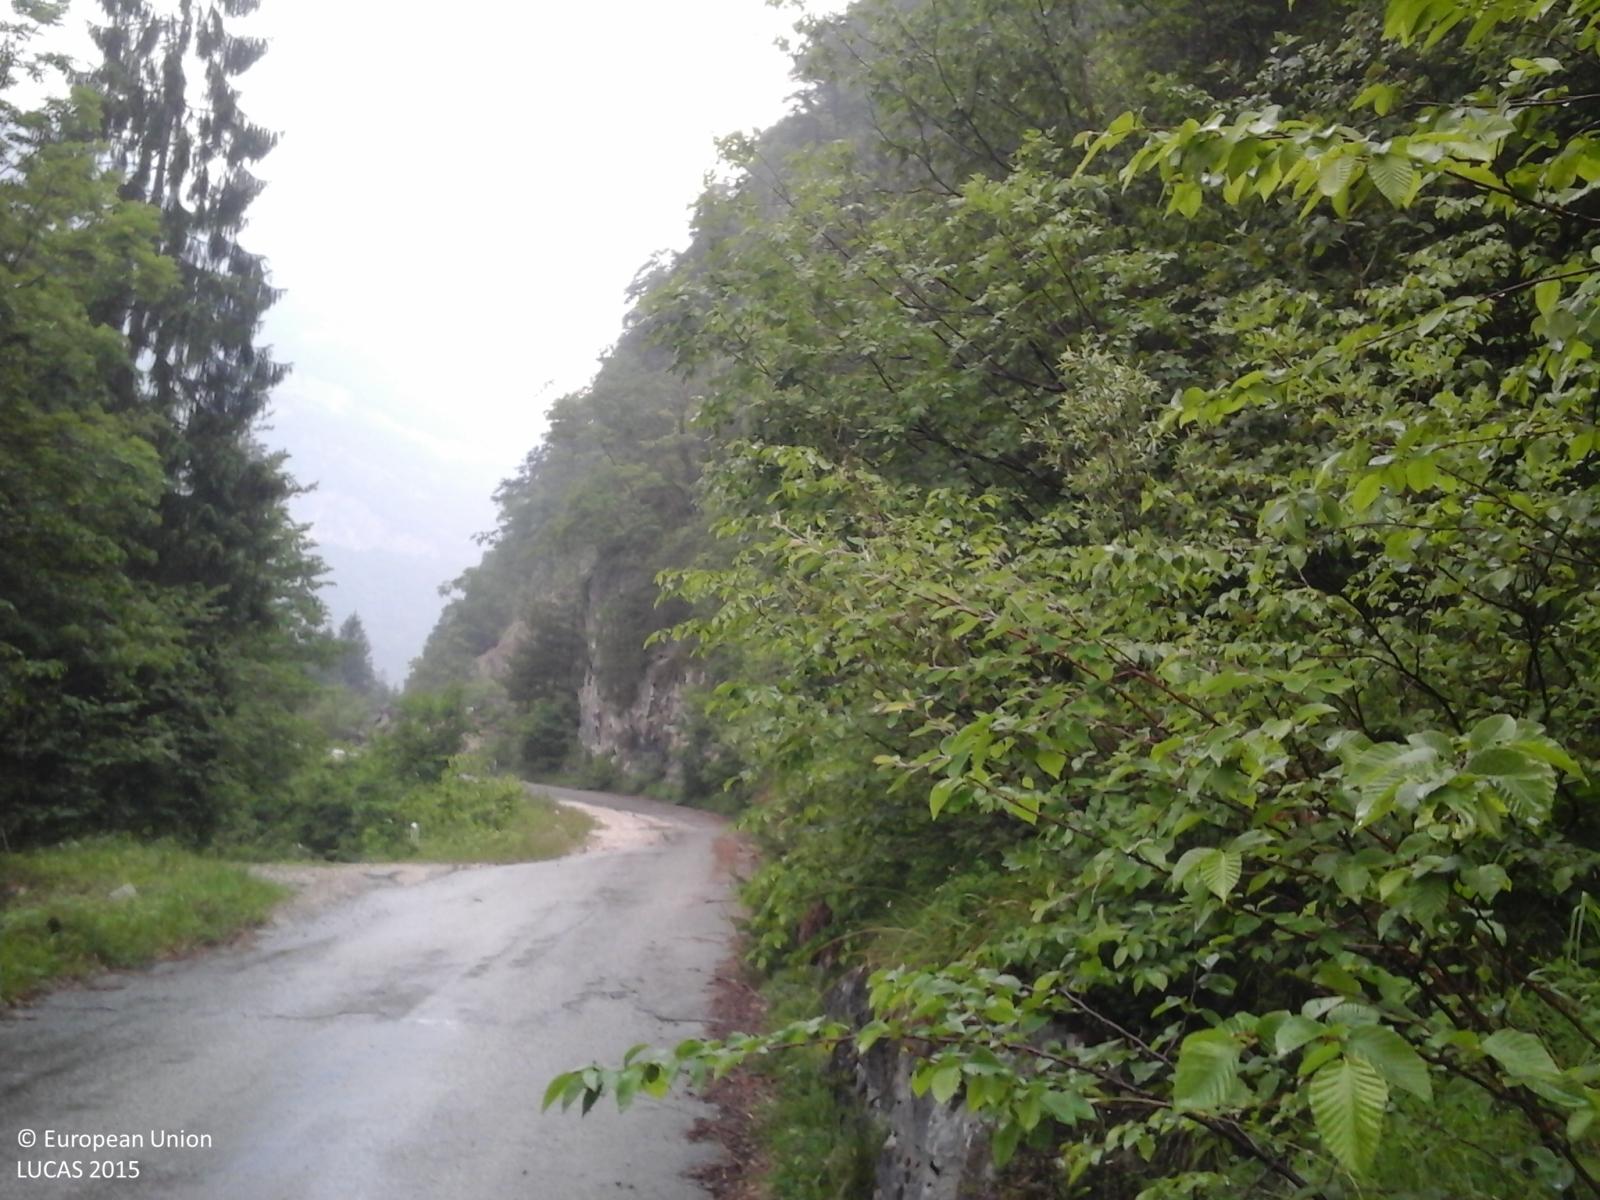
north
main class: Woodland
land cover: Pine dominated coniferous woodland
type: alpine coniferous forest
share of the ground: > 75 %
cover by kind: coniferous forest trees 100 %
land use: Forestry
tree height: > 5 m
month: May
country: IT
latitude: 46.1208
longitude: 11.7446
